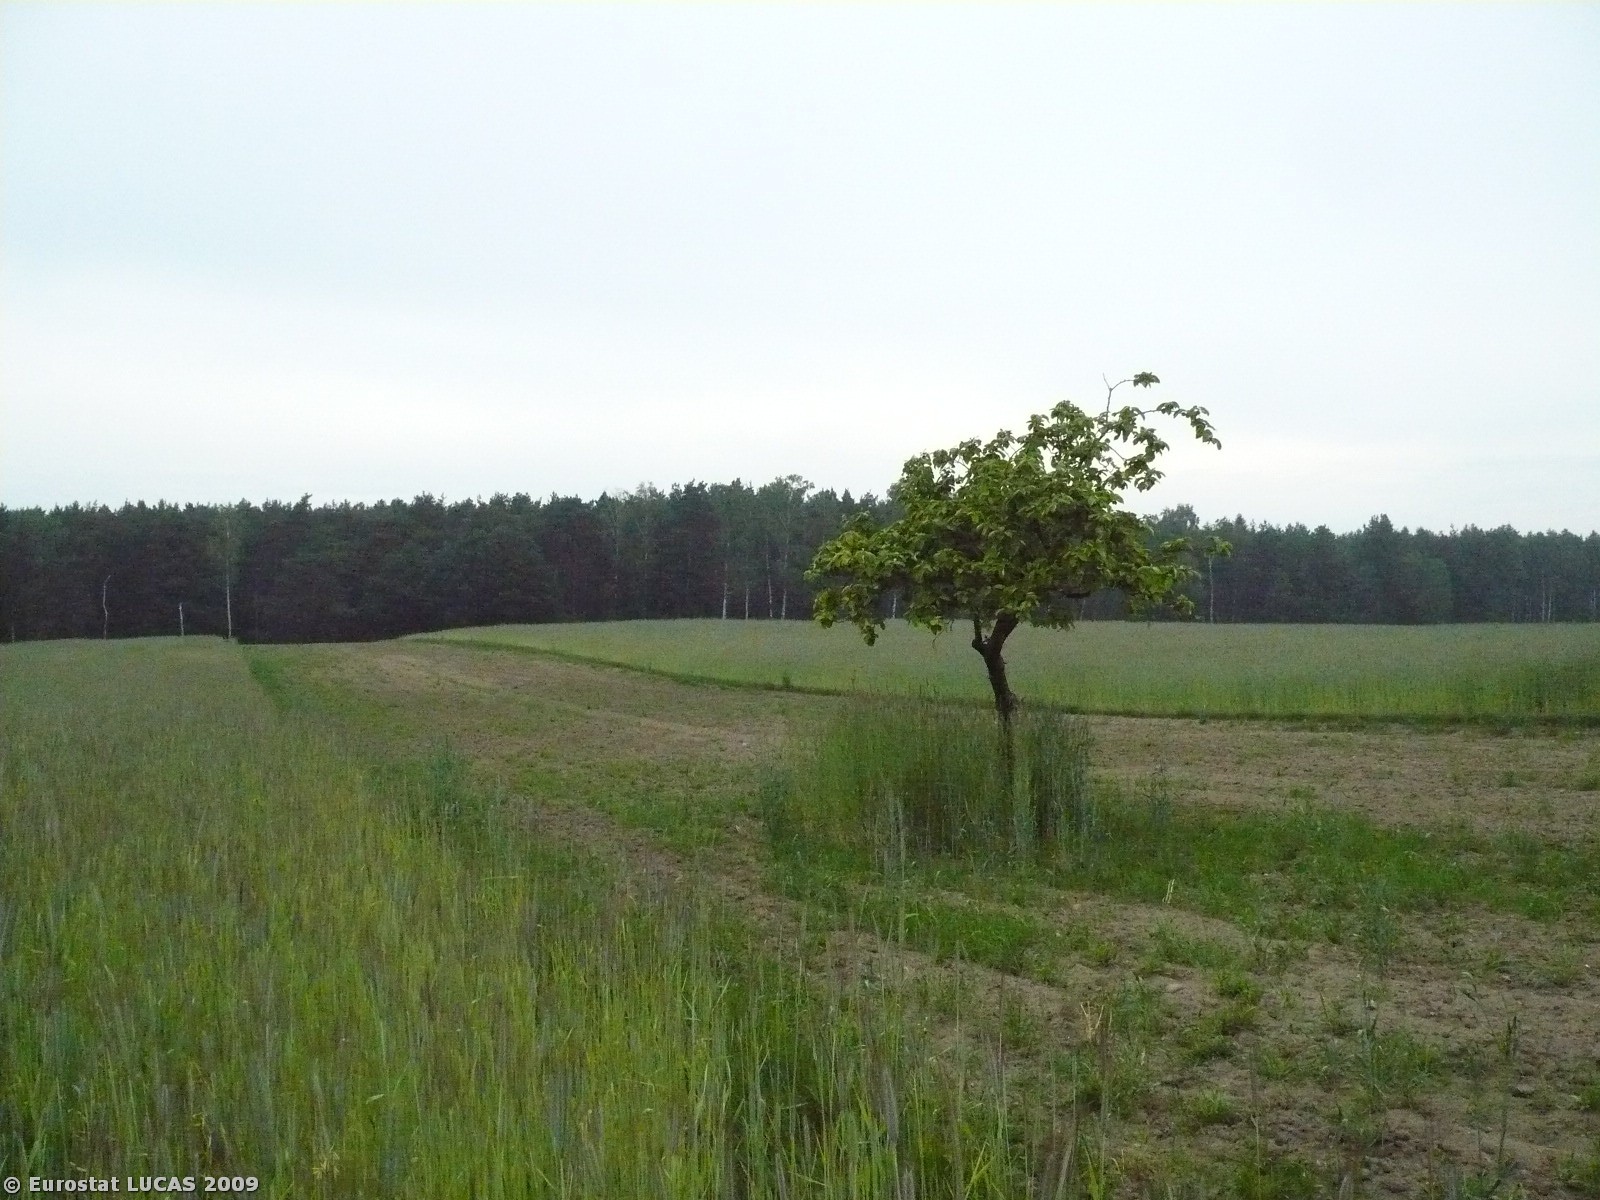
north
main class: Cropland
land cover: Rye
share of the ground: > 75 %
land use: Agriculture (excluding fallow land and kitchen gardens)
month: May
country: PL
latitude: 52.1752
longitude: 16.2800
